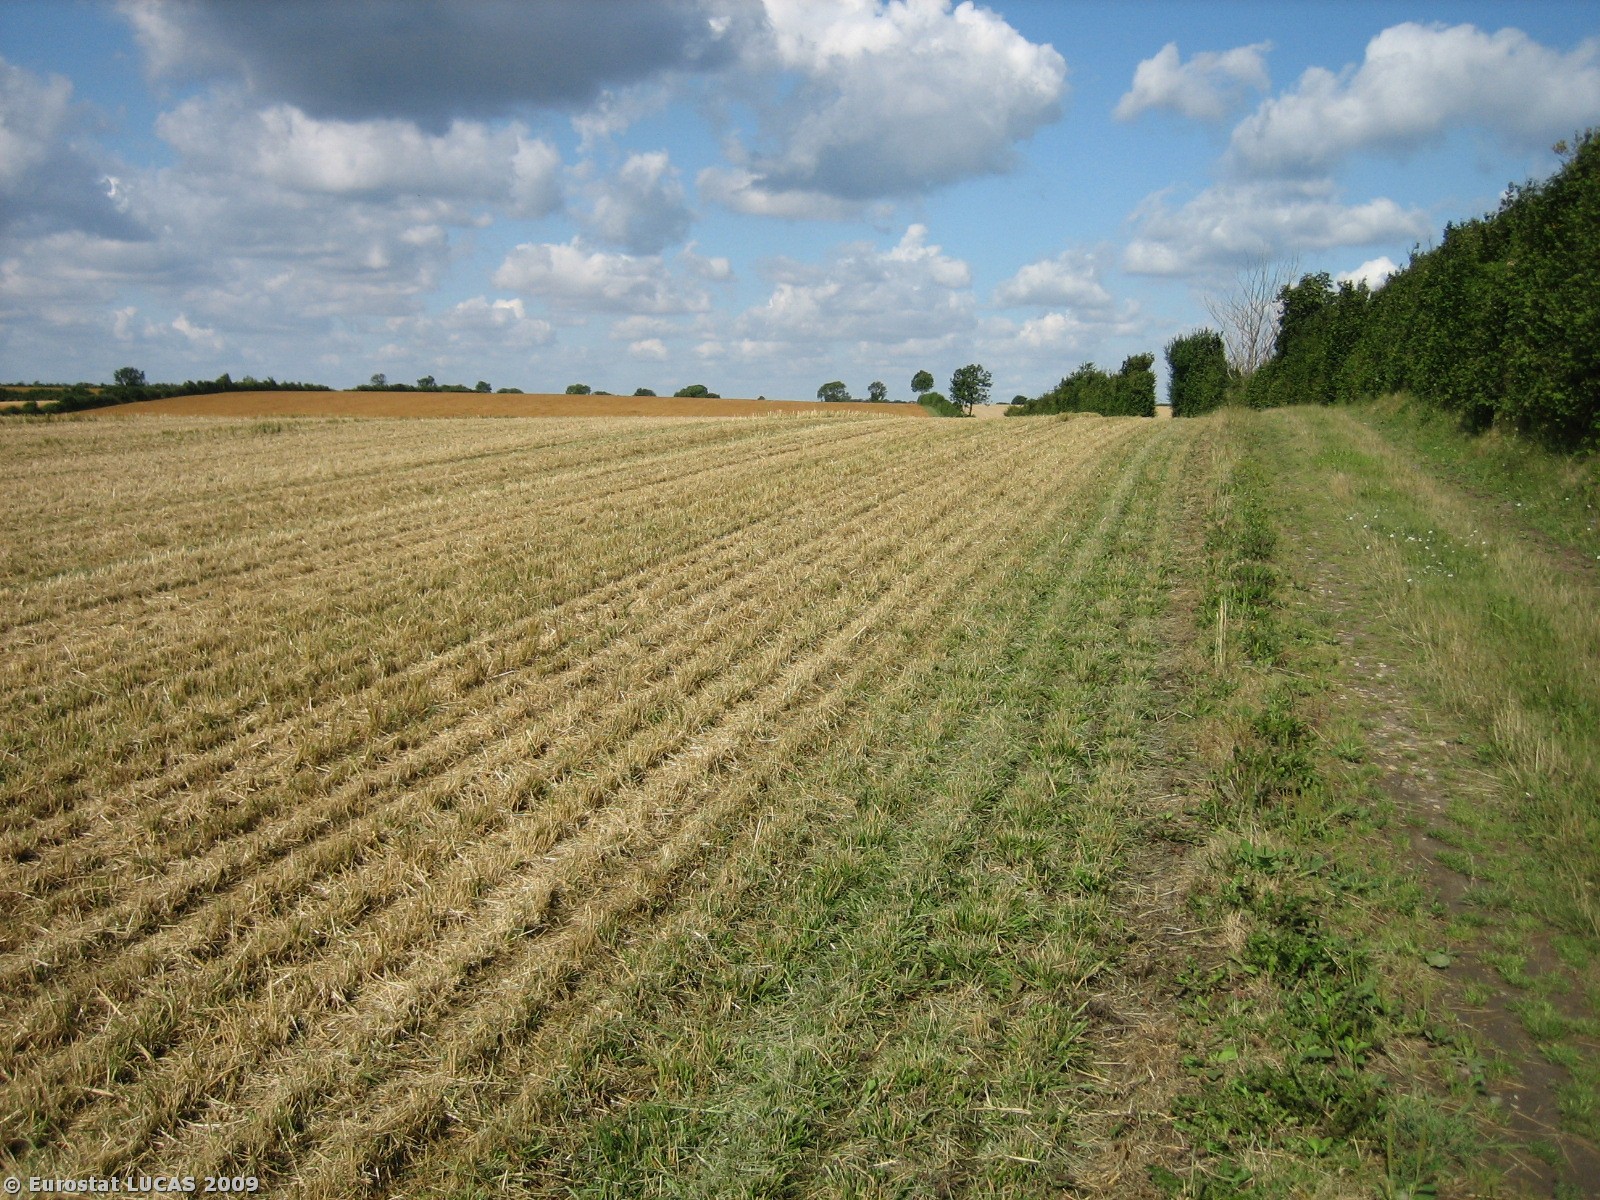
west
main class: Cropland
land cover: Temporary grasslands
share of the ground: > 75 %
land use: Agriculture (excluding fallow land and kitchen gardens)
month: July
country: DK
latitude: 55.3608
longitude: 9.8582
